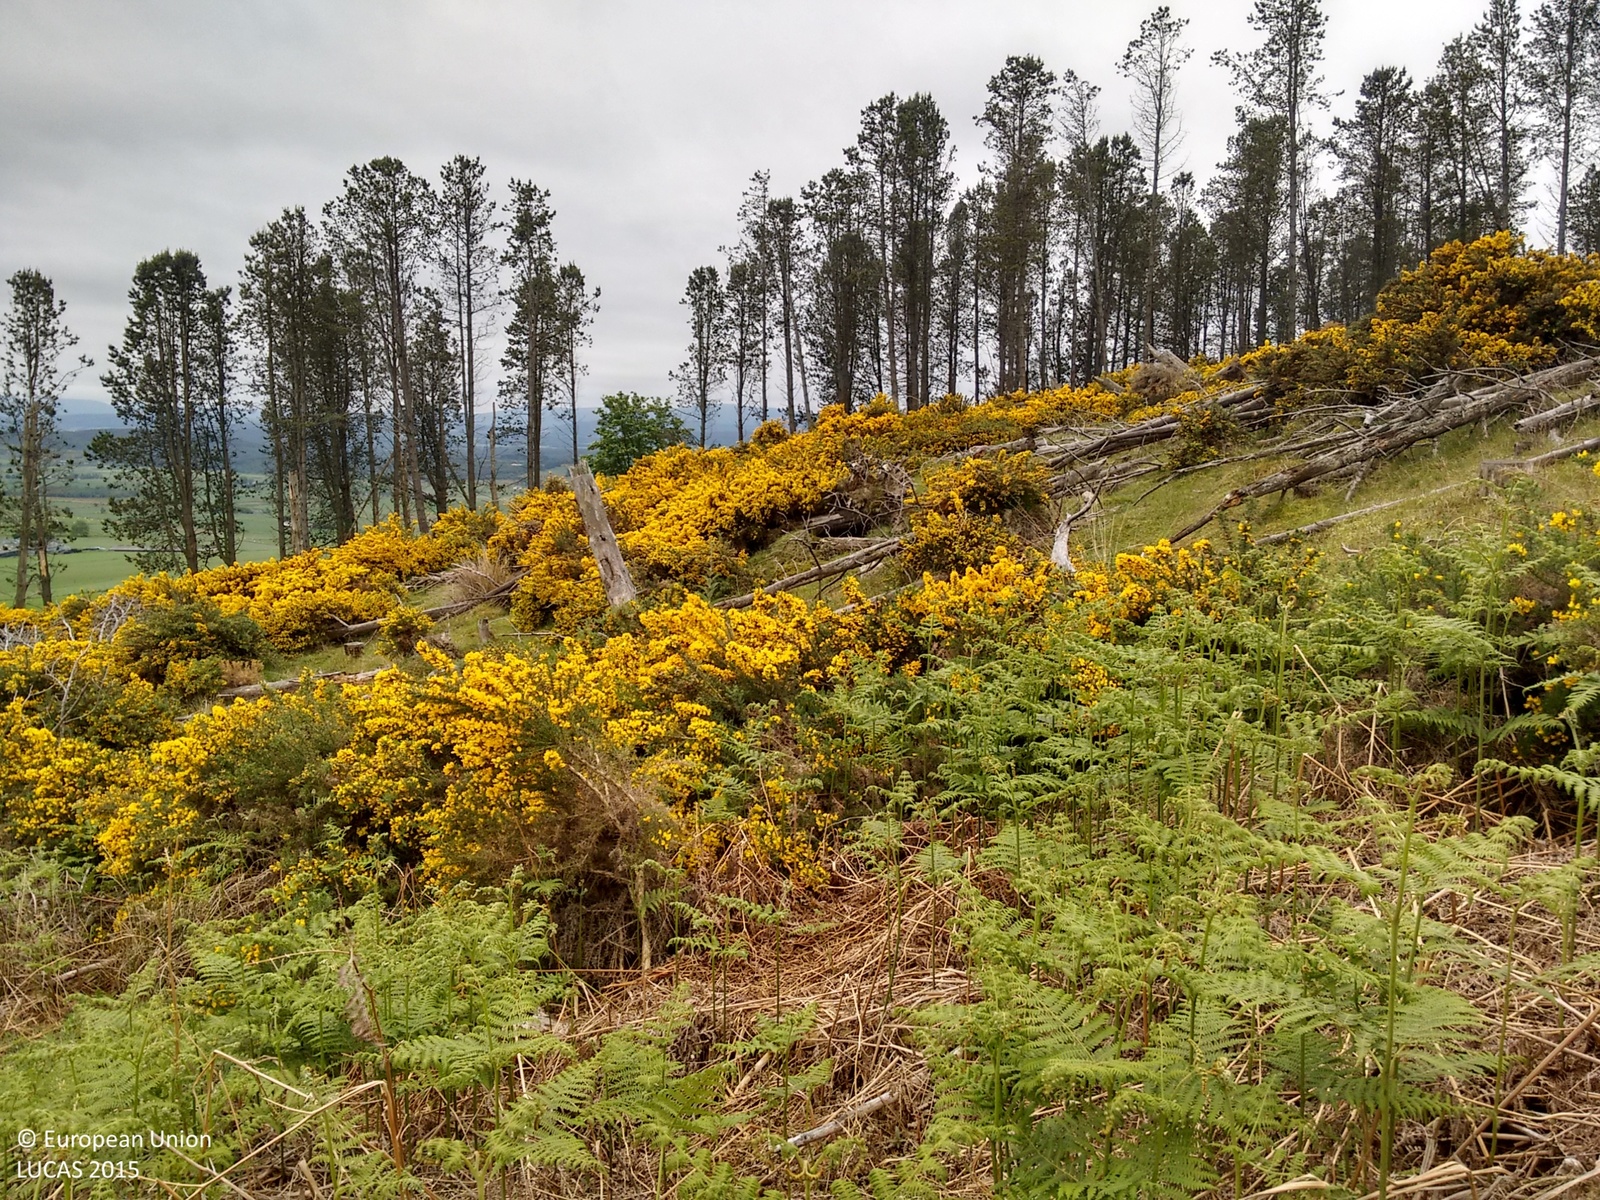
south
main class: Shrubland
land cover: Shrubland without tree cover
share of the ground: 50 - 75 %
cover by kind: shrubs 60 %, herbaceous plants 40 %
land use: Semi-natural and natural areas not in use
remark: Clear cut
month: June
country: GB
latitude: 57.1333
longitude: -2.7642
